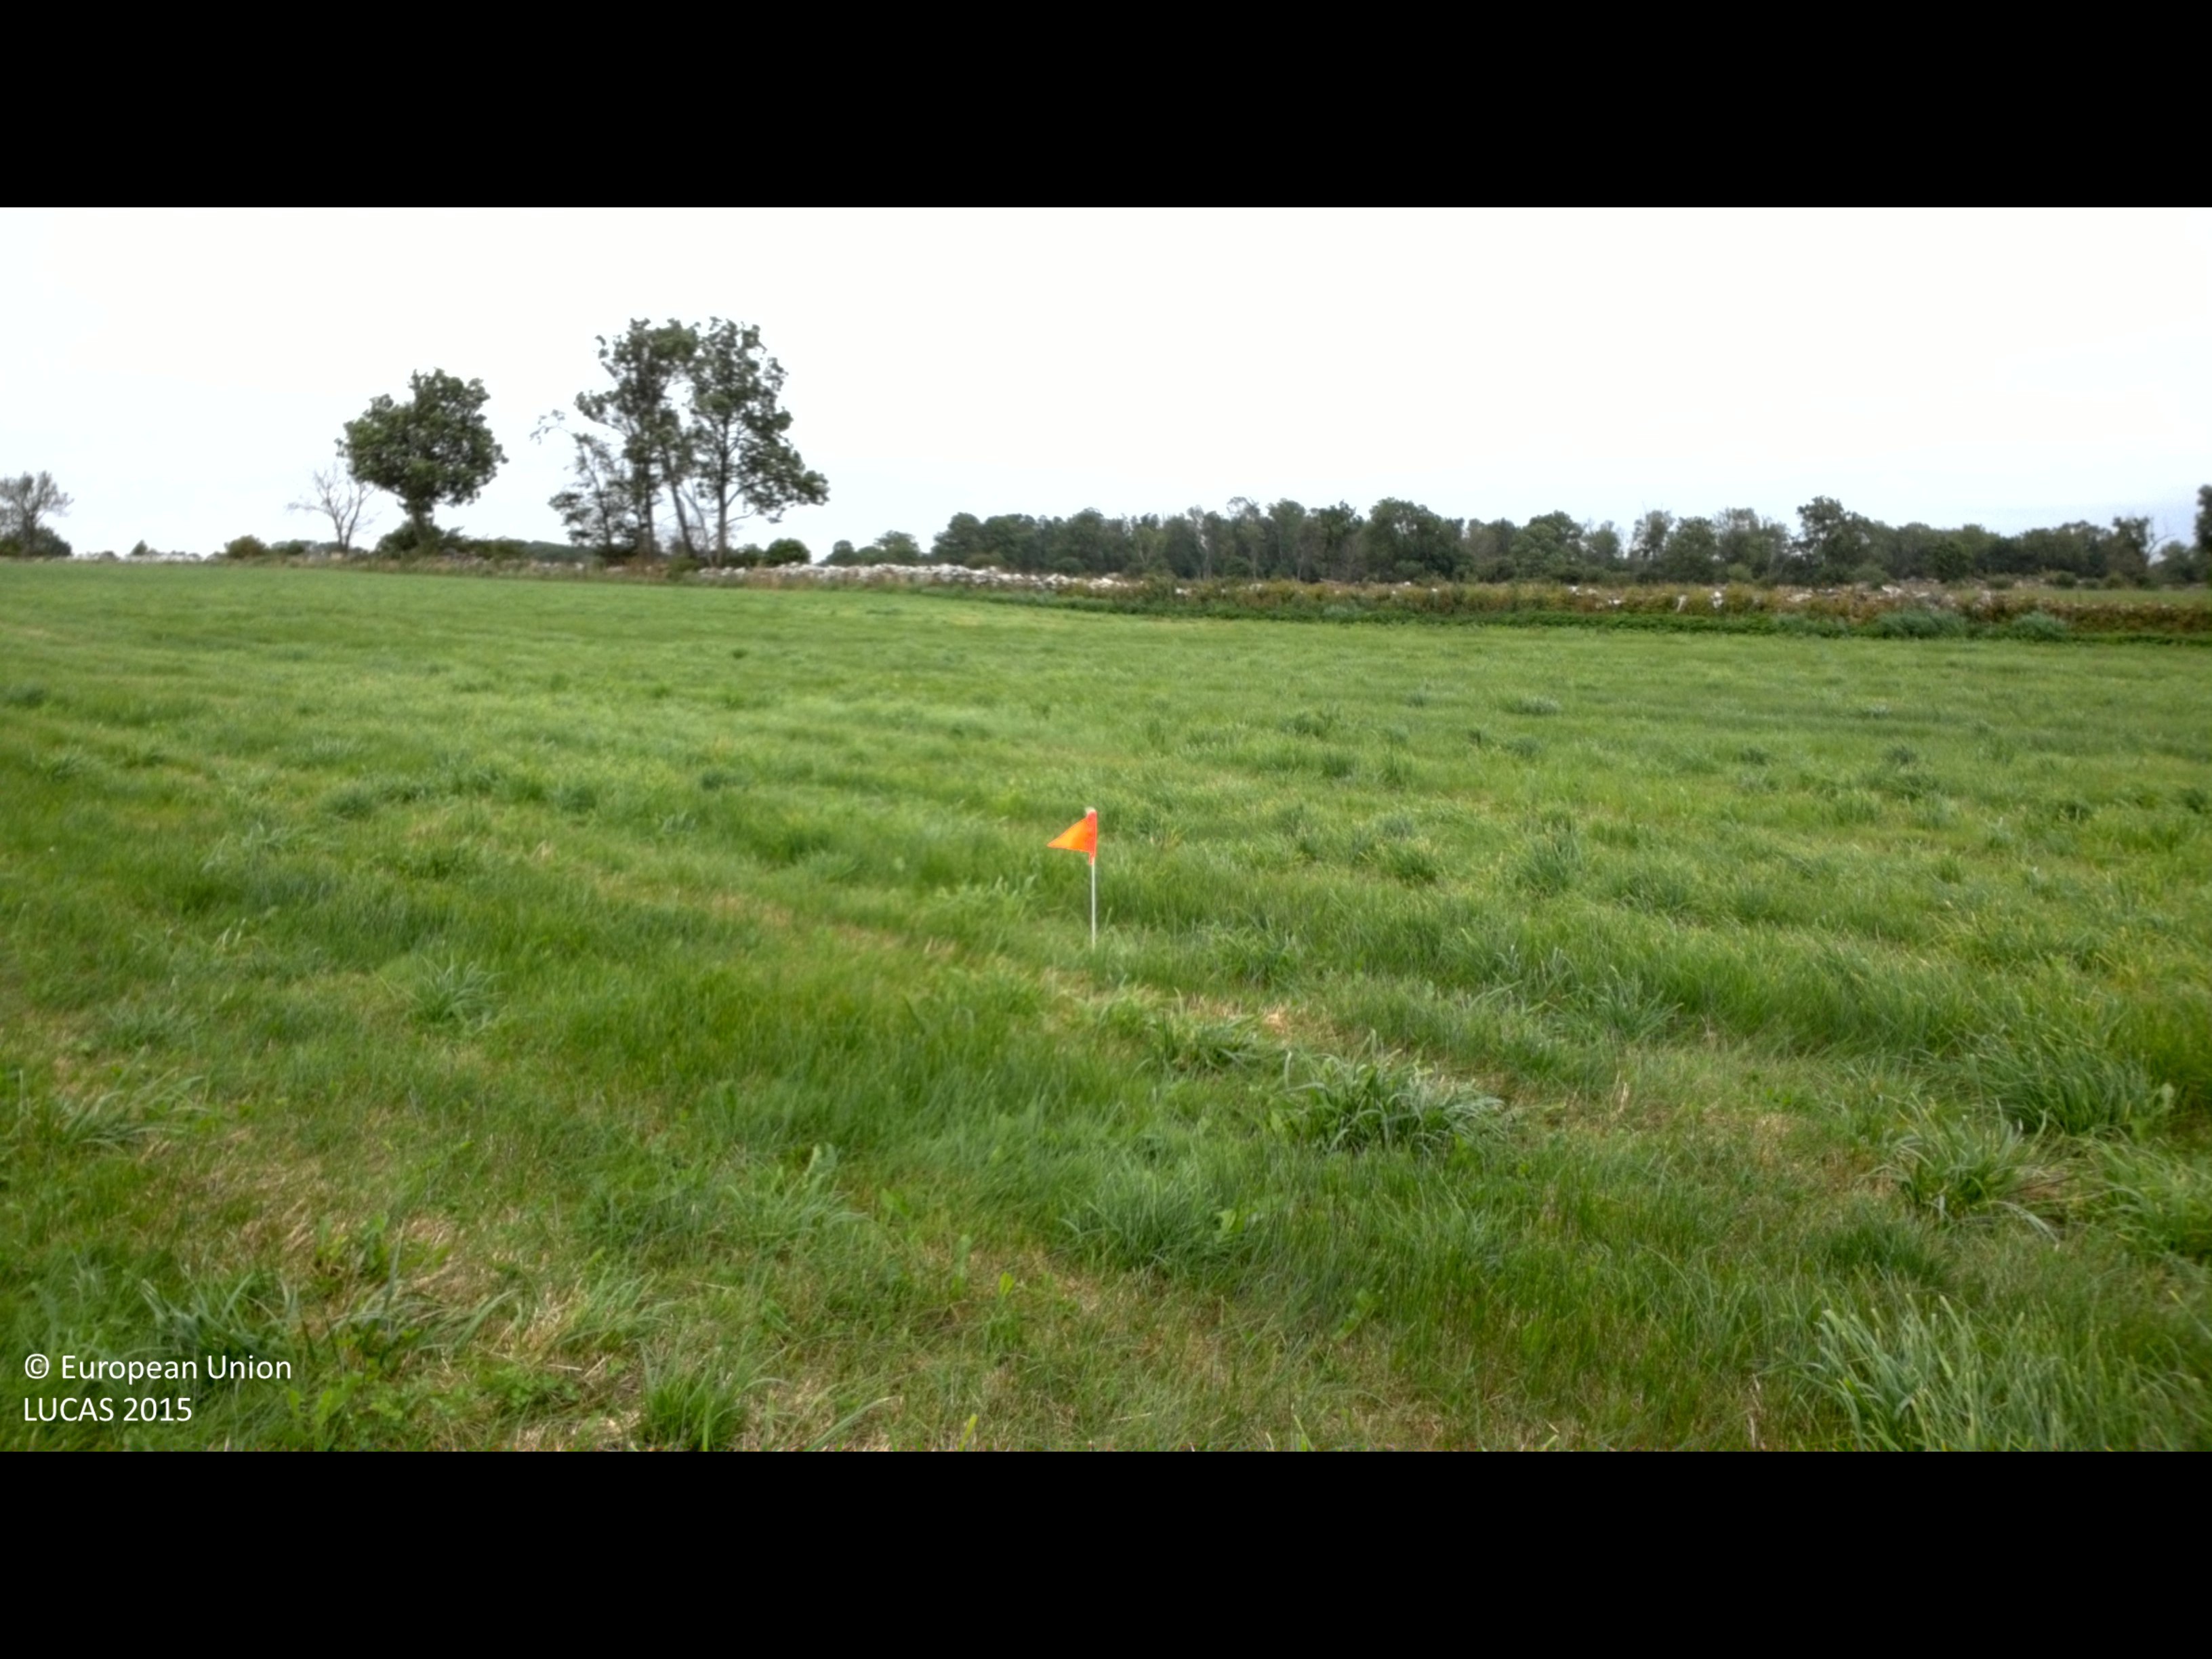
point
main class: Cropland
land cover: Temporary grasslands
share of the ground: > 75 %
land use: Agriculture (excluding fallow land and kitchen gardens)
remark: Harvested field
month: July
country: SE
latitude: 56.8101
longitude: 16.6351
